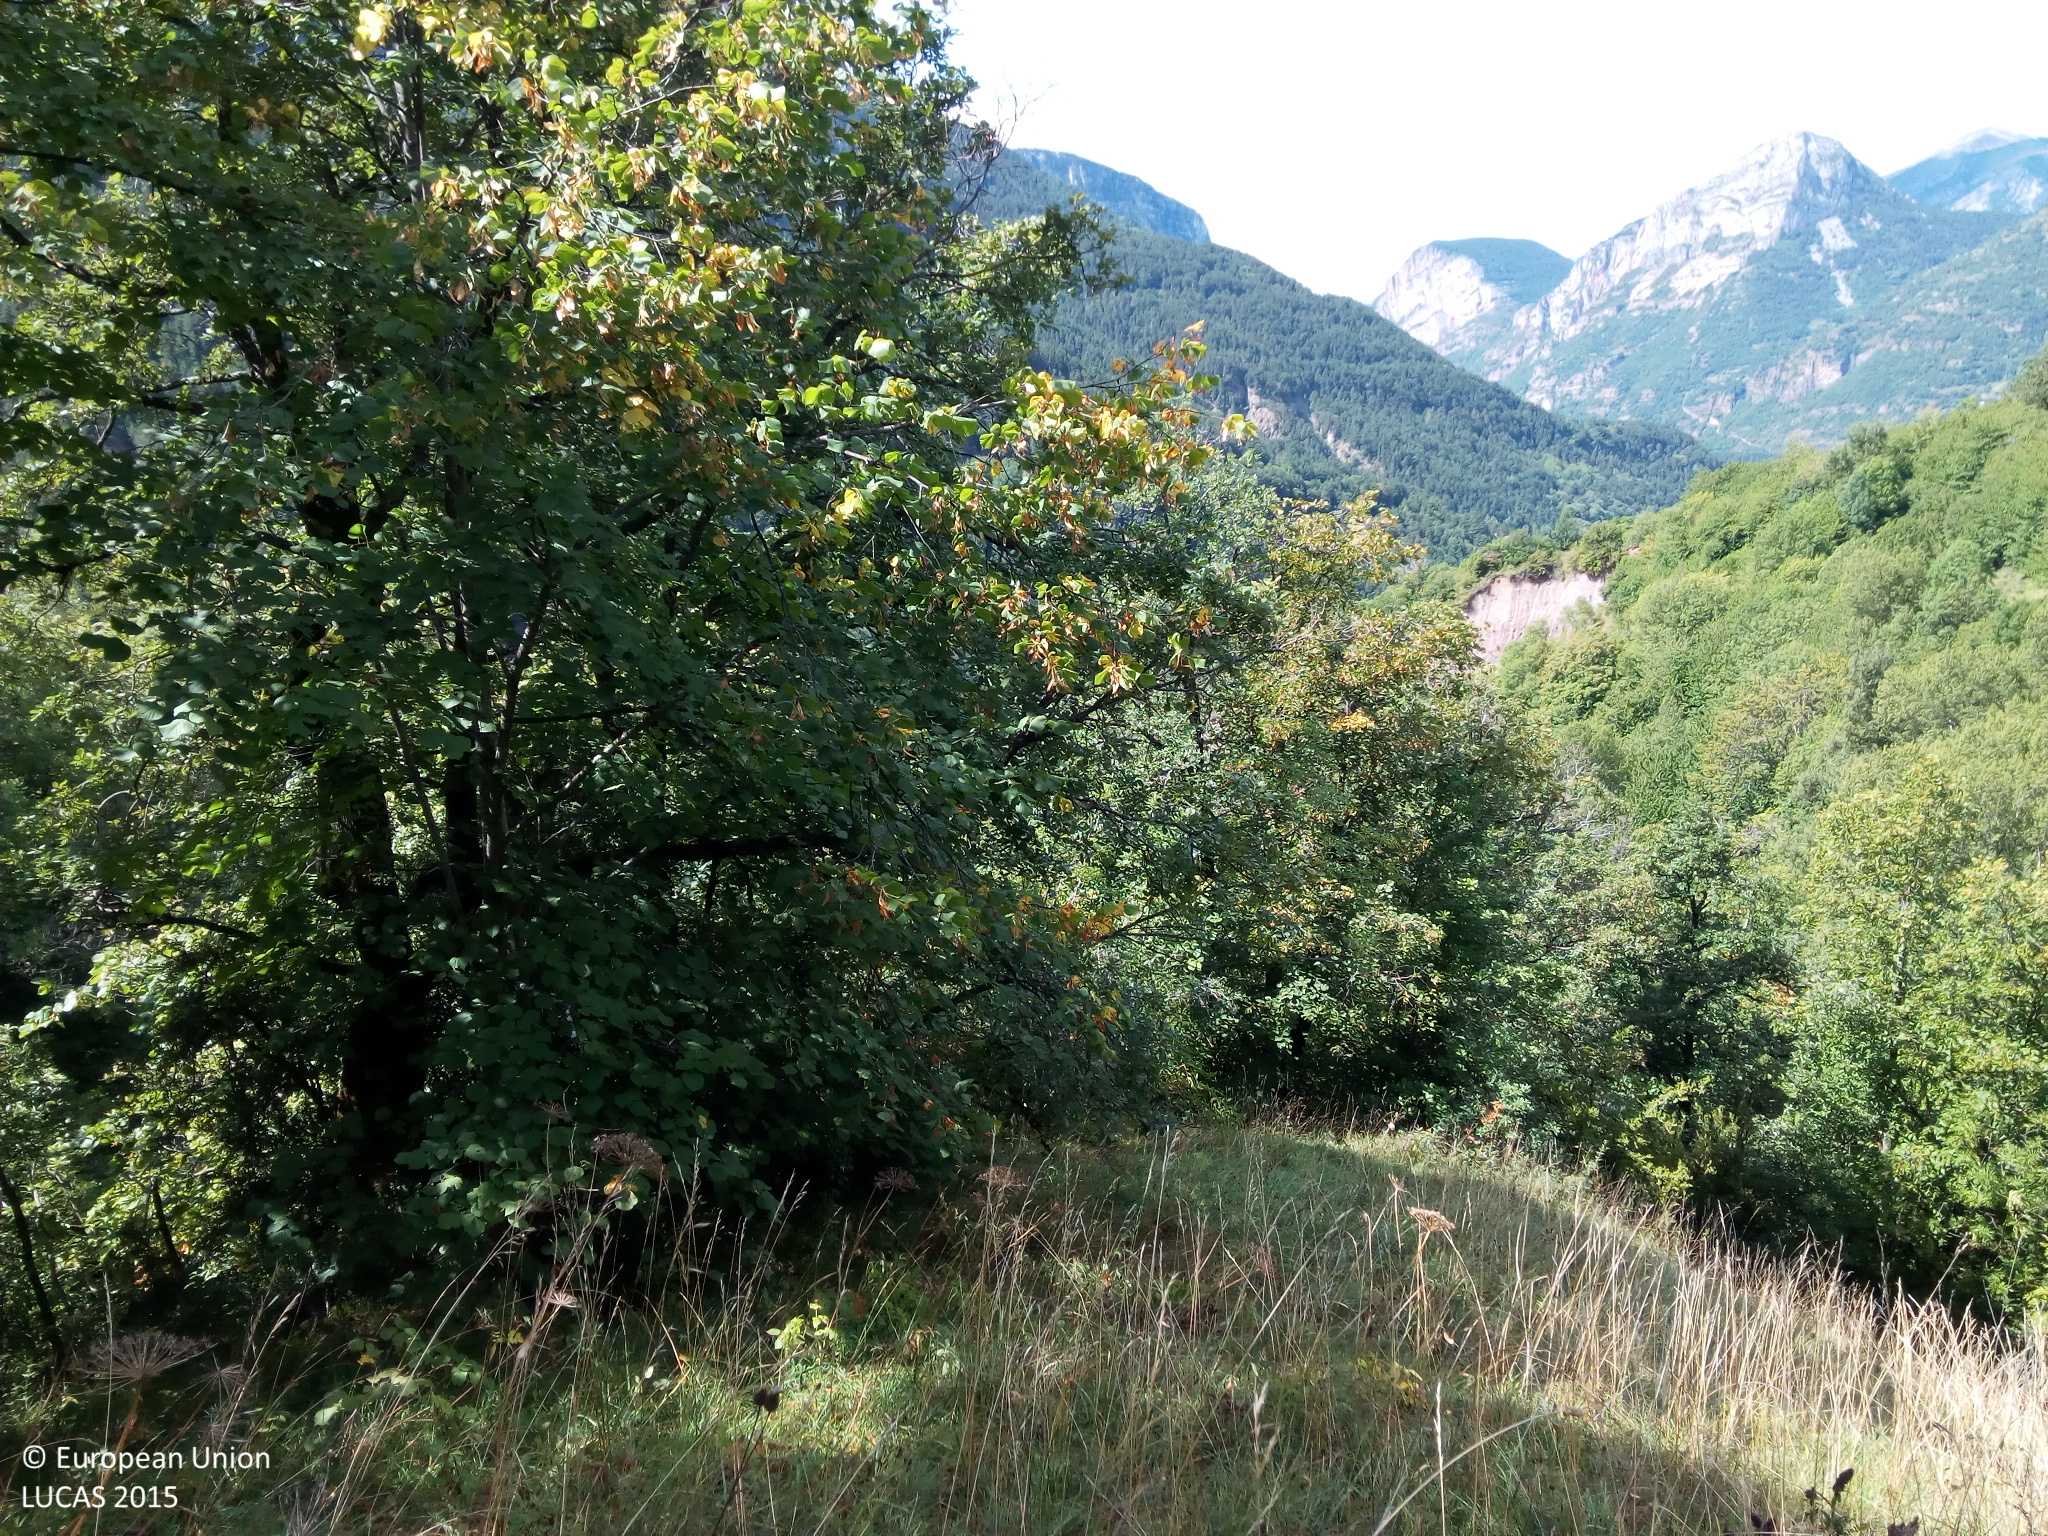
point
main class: Woodland
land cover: Broadleaved woodland
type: floodplain forest
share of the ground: > 75 %
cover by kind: broadleaved forest trees 80 %, herbaceous plants 15 %, shrubs 5 %
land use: Semi-natural and natural areas not in use
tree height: > 5 m
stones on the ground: < 10 %
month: September
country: ES
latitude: 42.5755
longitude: 0.3665
